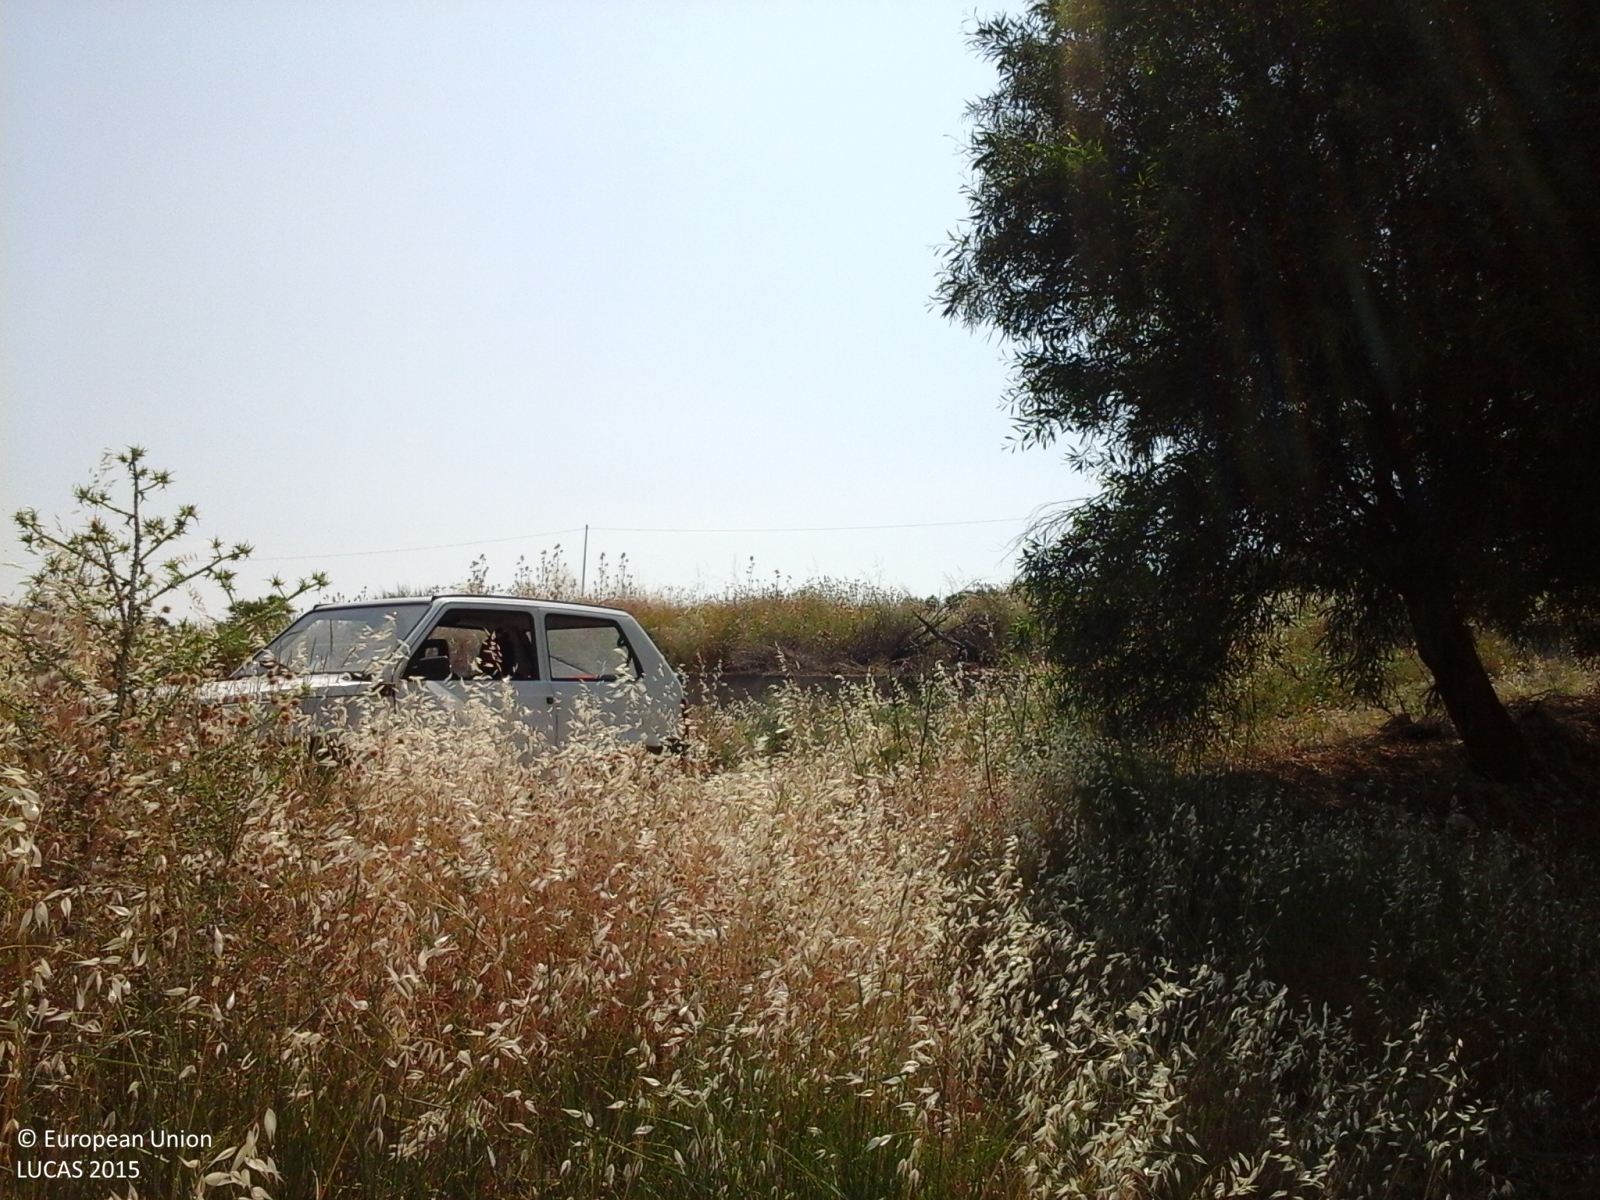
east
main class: Grassland
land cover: Grassland without tree/shrub cover
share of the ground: > 75 %
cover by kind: herbaceous plants 100 %
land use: Semi-natural and natural areas not in use
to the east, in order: Grassland without tree/shrub cover; Tracks; Other bare soil; Artificial constructions; Grass margins; Single bushes/trees; Paved roads, cycling and walking lanes; Grass margins; Temporary grasslands; Electric lines; Temporary grasslands; Spontaneously vegetated surfaces; Olive groves; Tracks; Grassland without tree/shrub cover
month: June
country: IT
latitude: 37.3385
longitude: 13.4832
